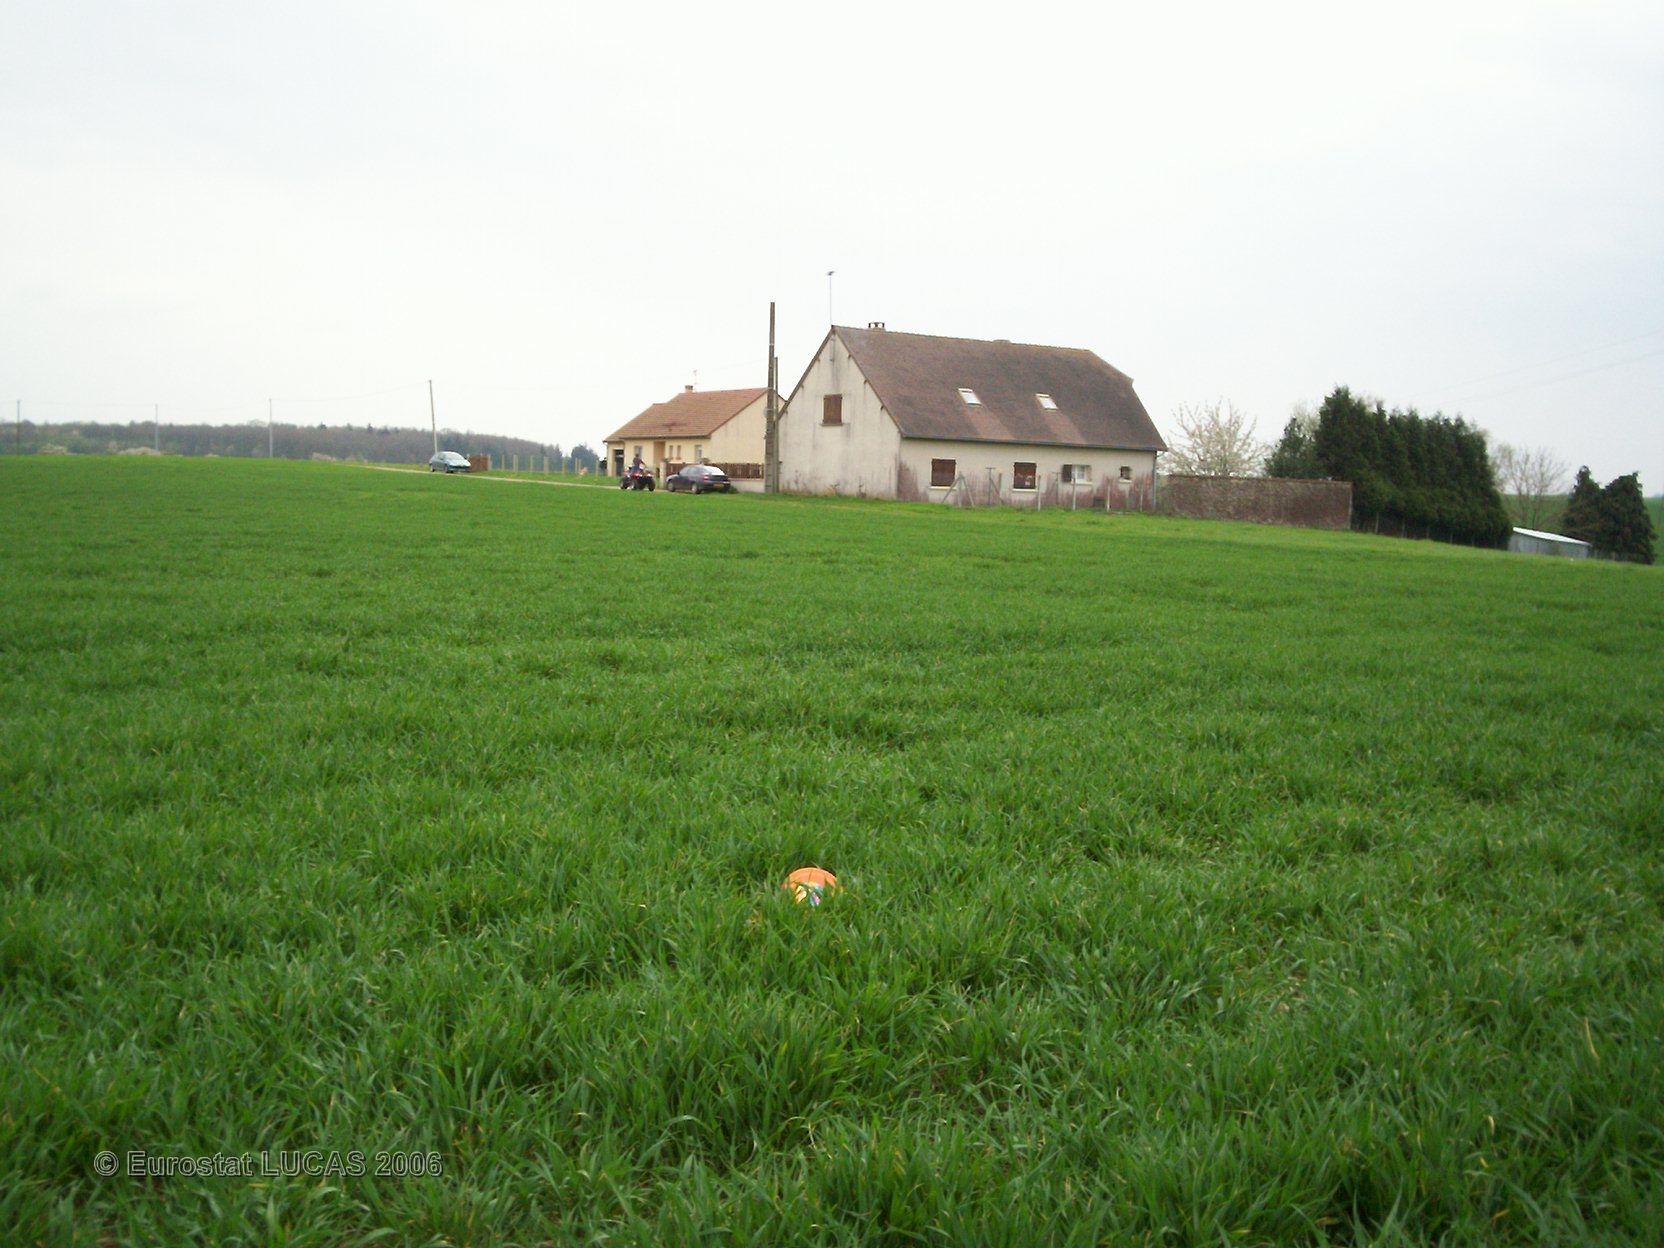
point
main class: Cropland
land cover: Common wheat
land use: Agriculture (excluding fallow land and kitchen gardens)
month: April
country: FR
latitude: 48.8568
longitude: 1.0791
